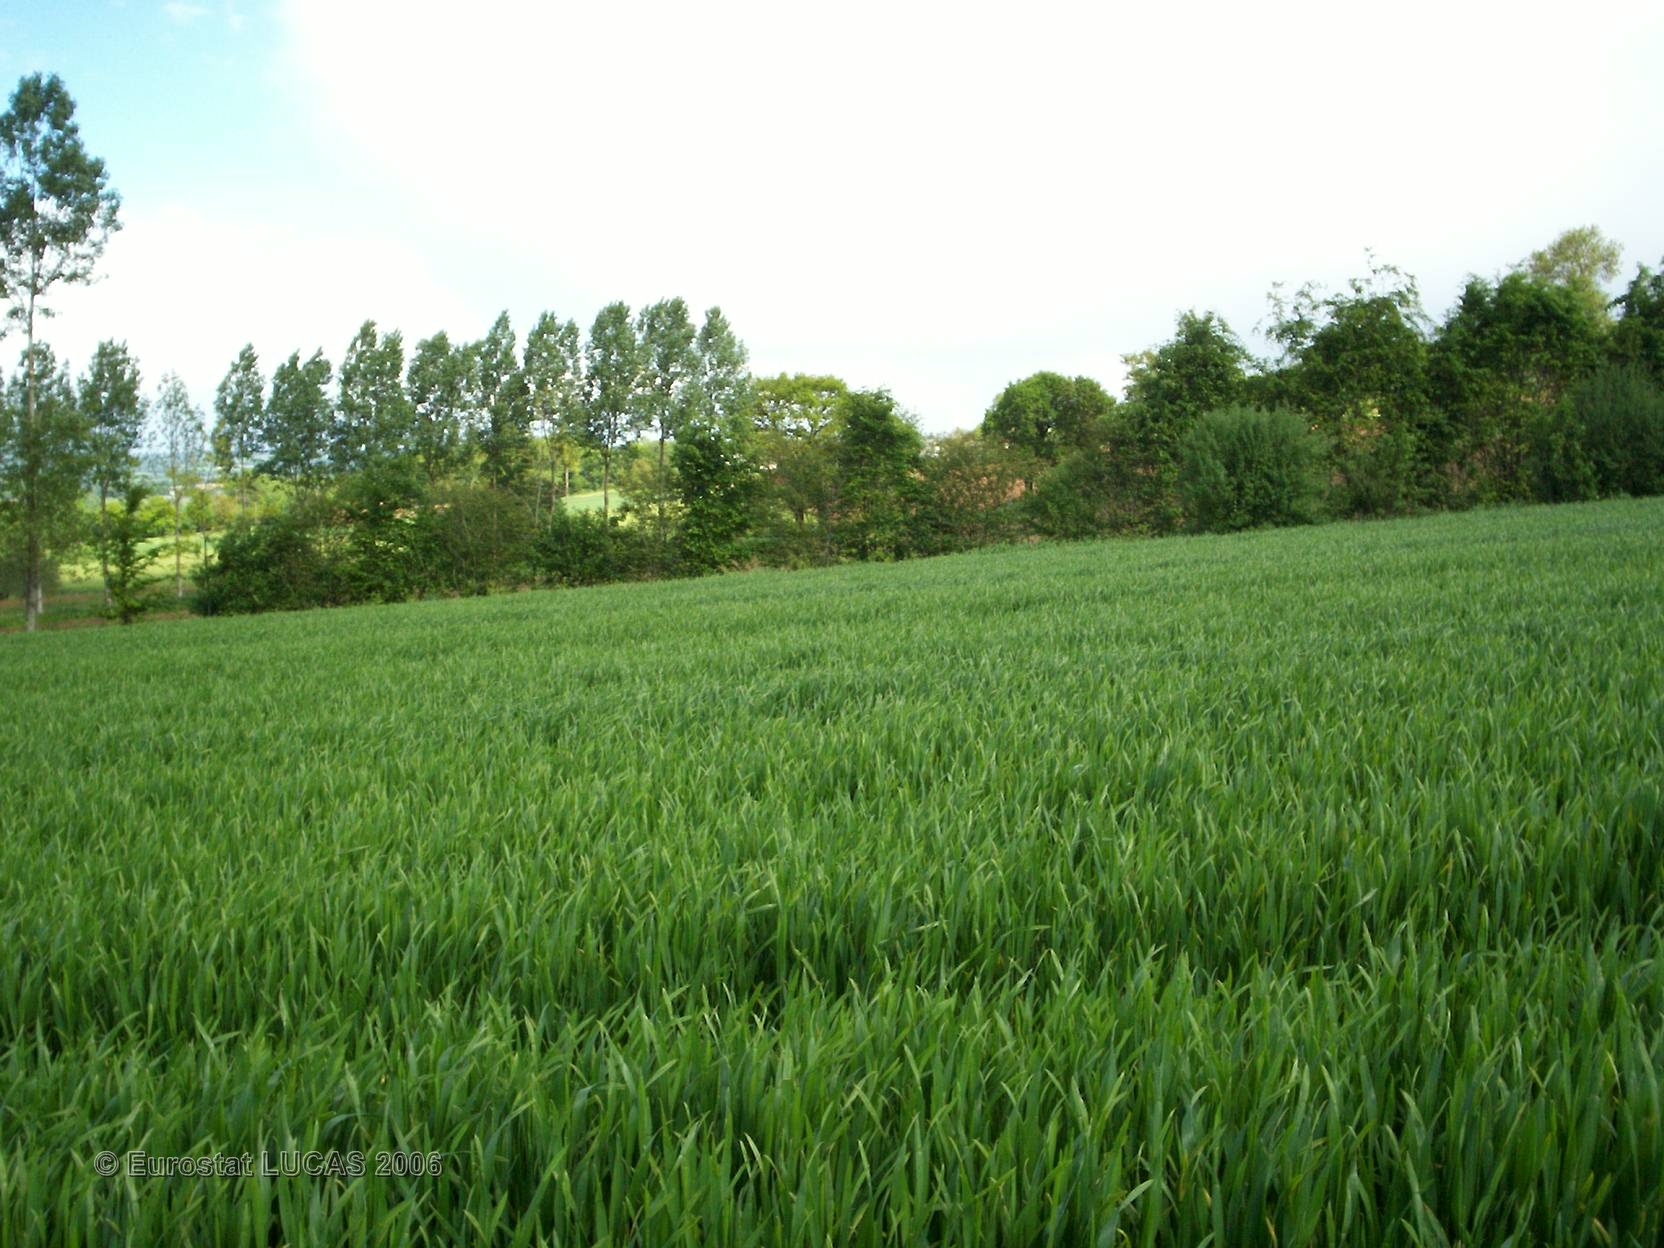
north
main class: Cropland
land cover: Common wheat
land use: Agriculture (excluding fallow land and kitchen gardens)
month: May
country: FR
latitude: 48.2951
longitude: -2.9410
